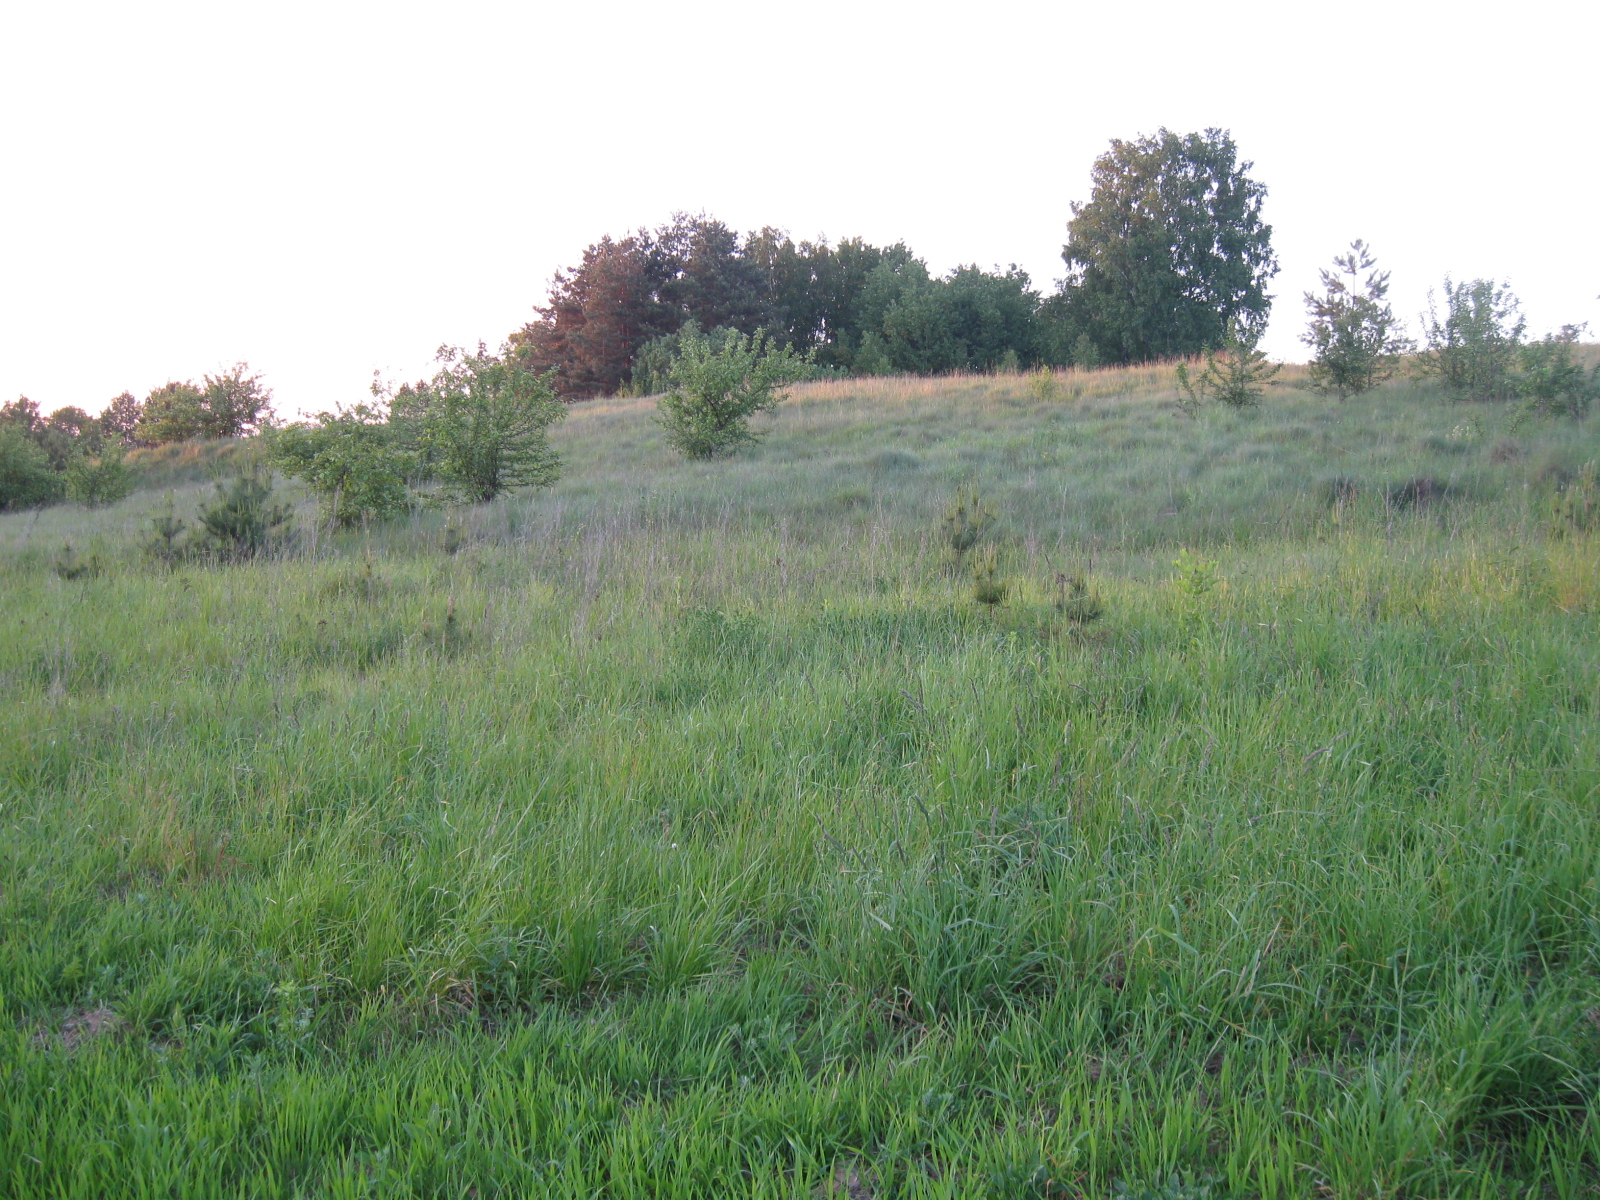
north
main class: Cropland
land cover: Oats
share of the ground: > 75 %
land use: Agriculture (excluding fallow land and kitchen gardens)
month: June
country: LT
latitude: 54.1904
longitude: 23.6800
